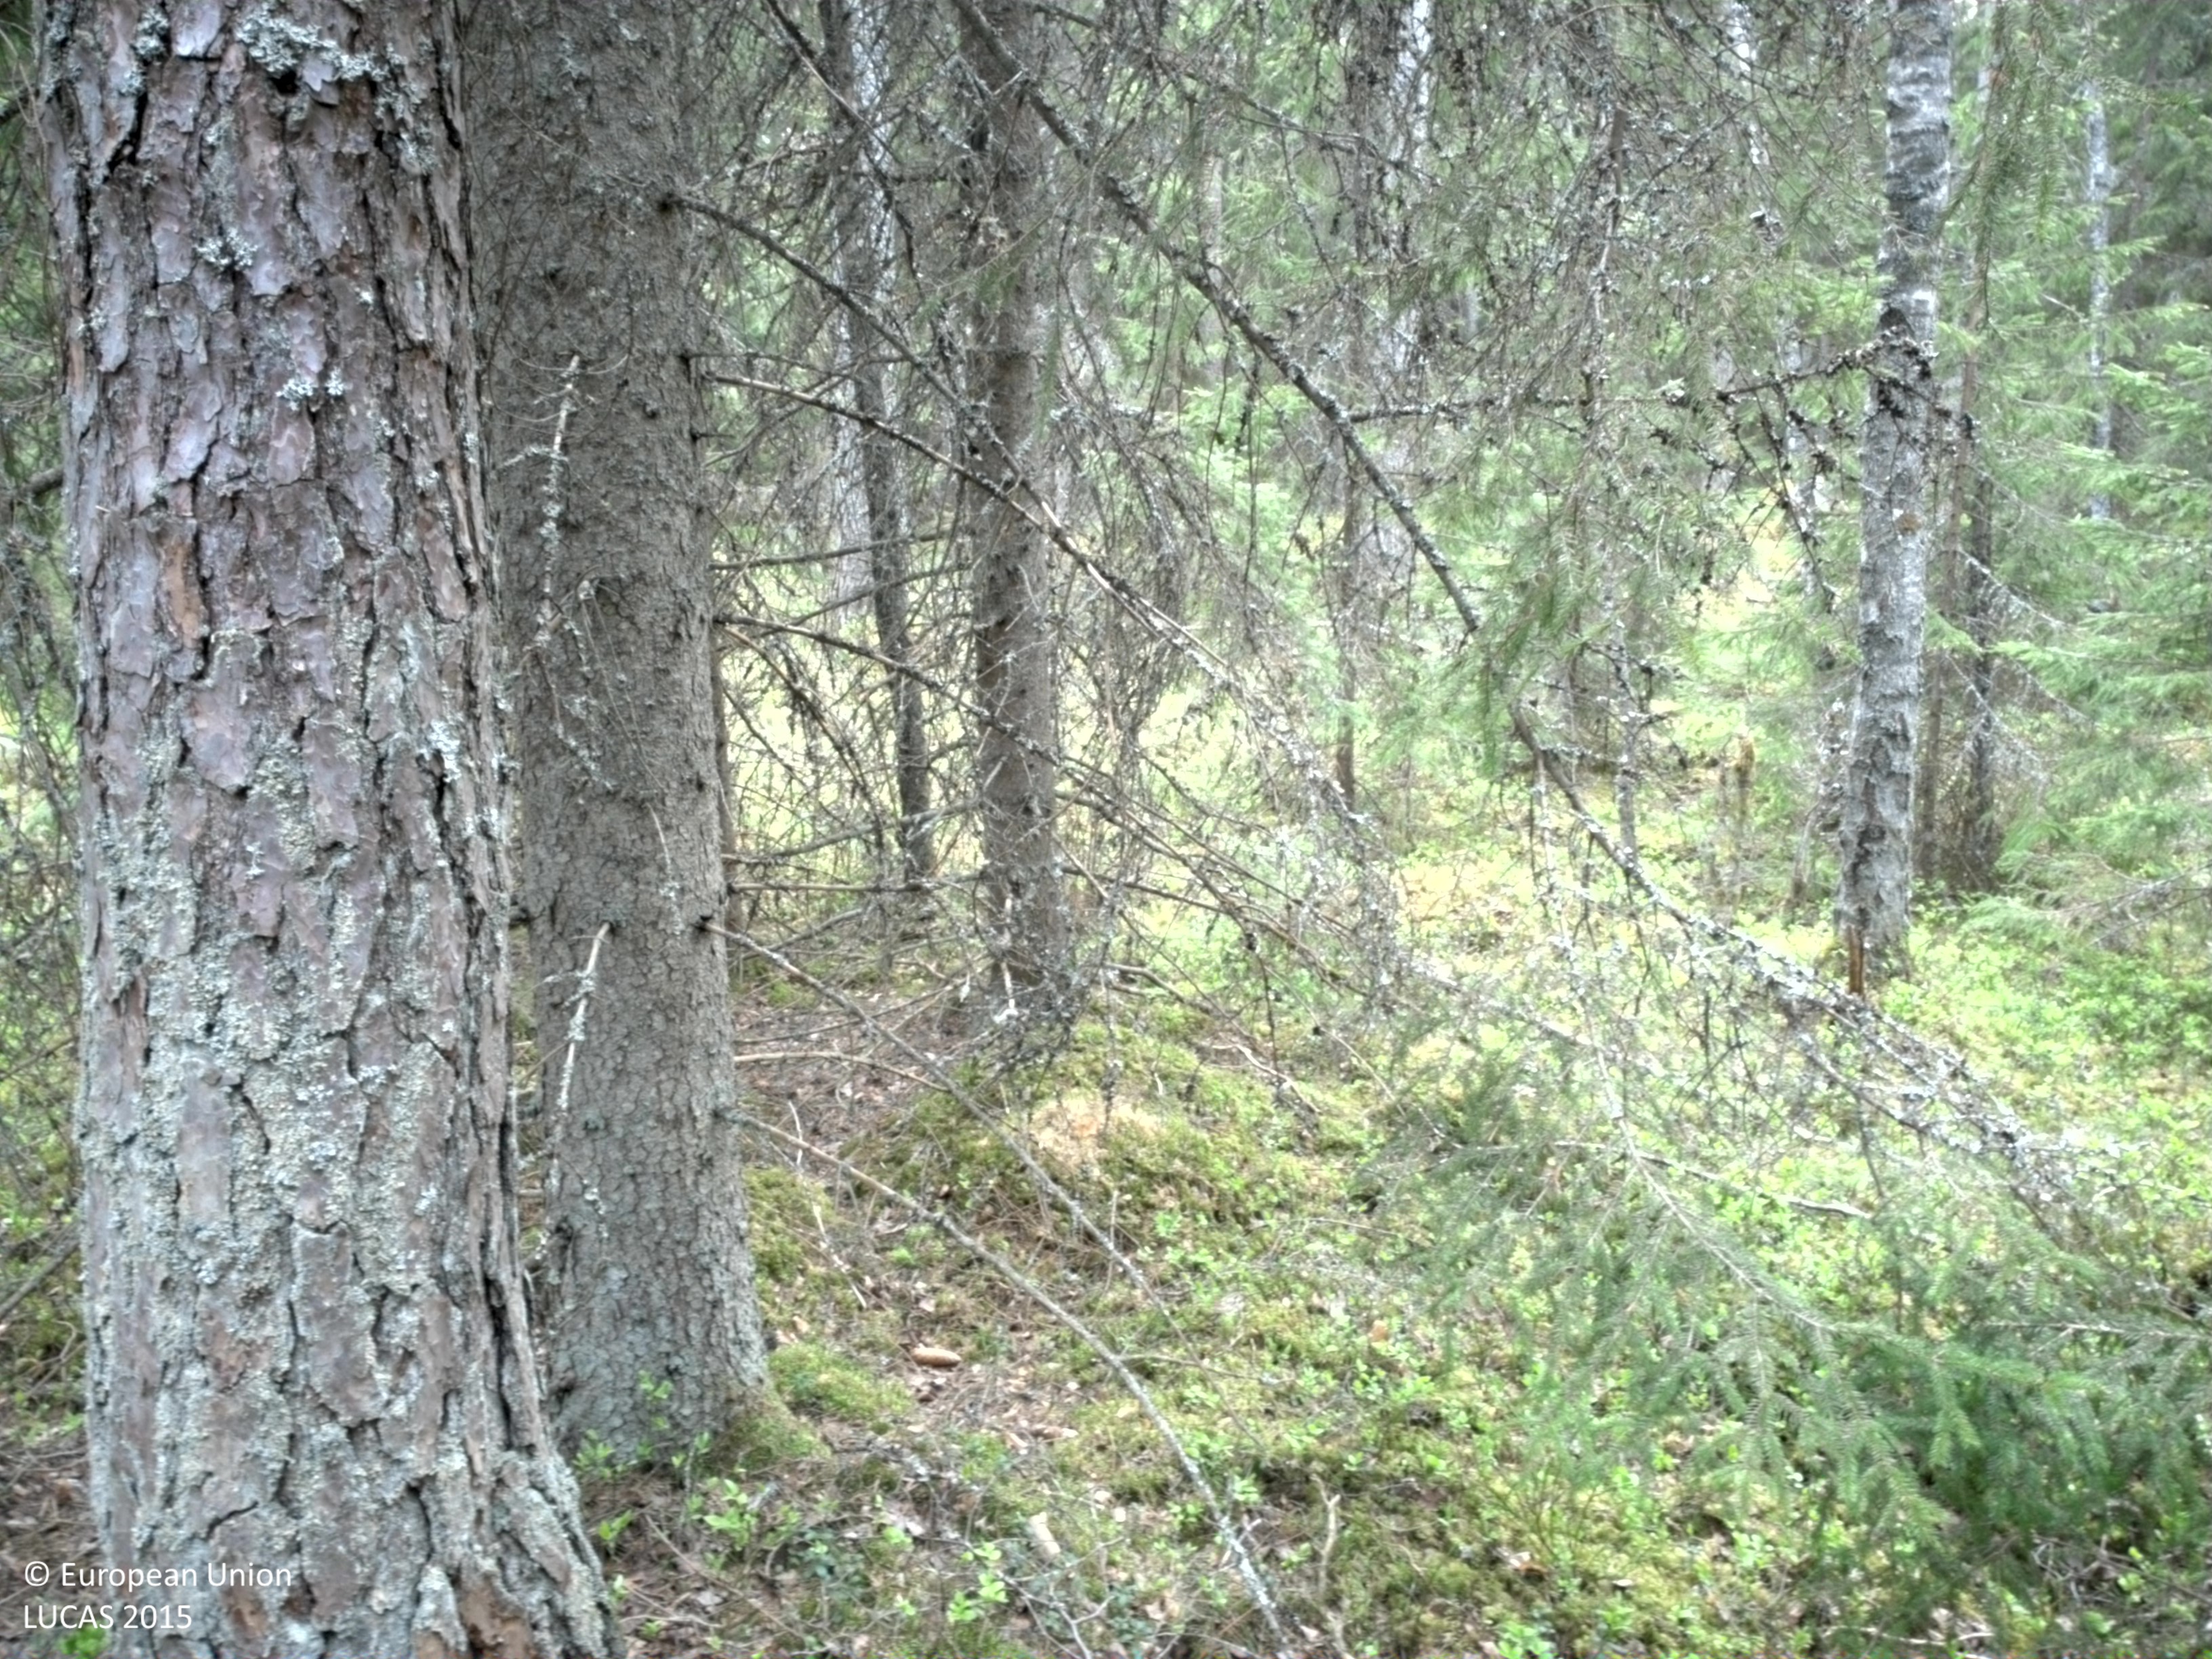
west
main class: Woodland
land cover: Spruce dominated mixed woodland
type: boreal forest
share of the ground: 50 - 75 %
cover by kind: coniferous forest trees 50 %, broadleaved forest trees 25 %, shrubs 15 %, lichens and mosses 10 %
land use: Forestry
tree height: > 5 m
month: May
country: SE
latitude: 56.7034
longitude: 15.4373
